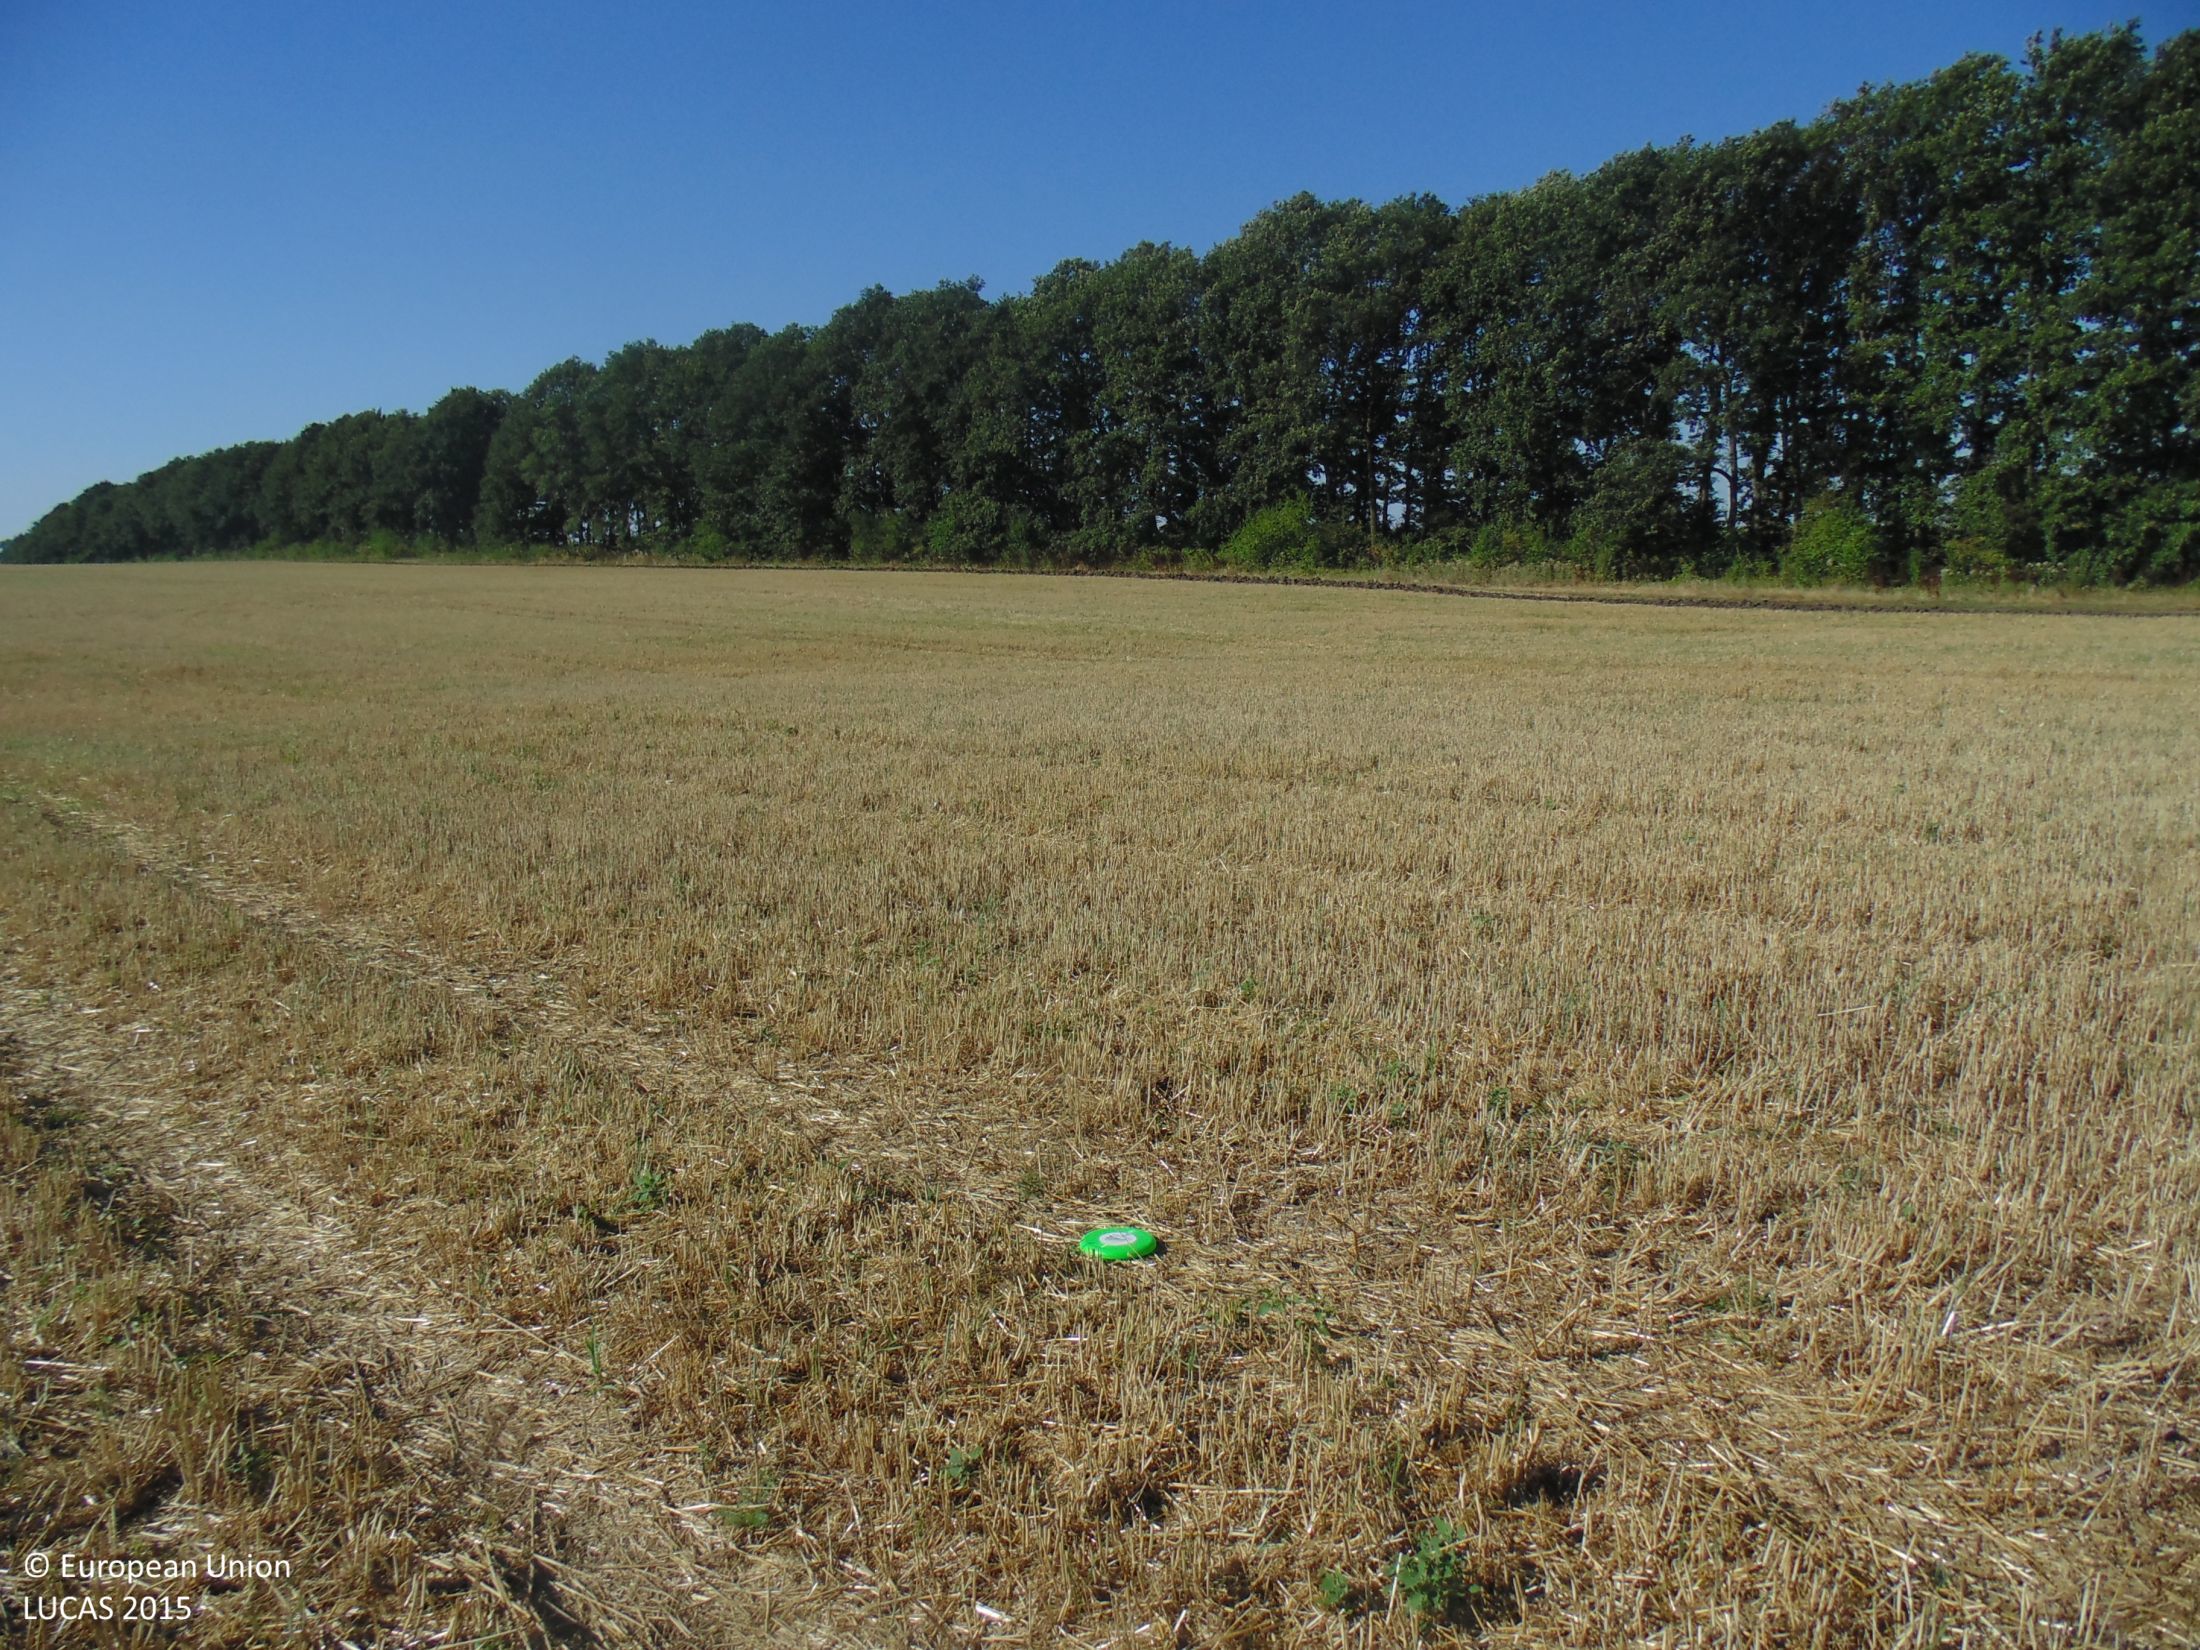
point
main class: Cropland
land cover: Common wheat
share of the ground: 25 - 50 %
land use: Agriculture (excluding fallow land and kitchen gardens)
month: July
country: BG
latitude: 43.5218
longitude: 28.0750
